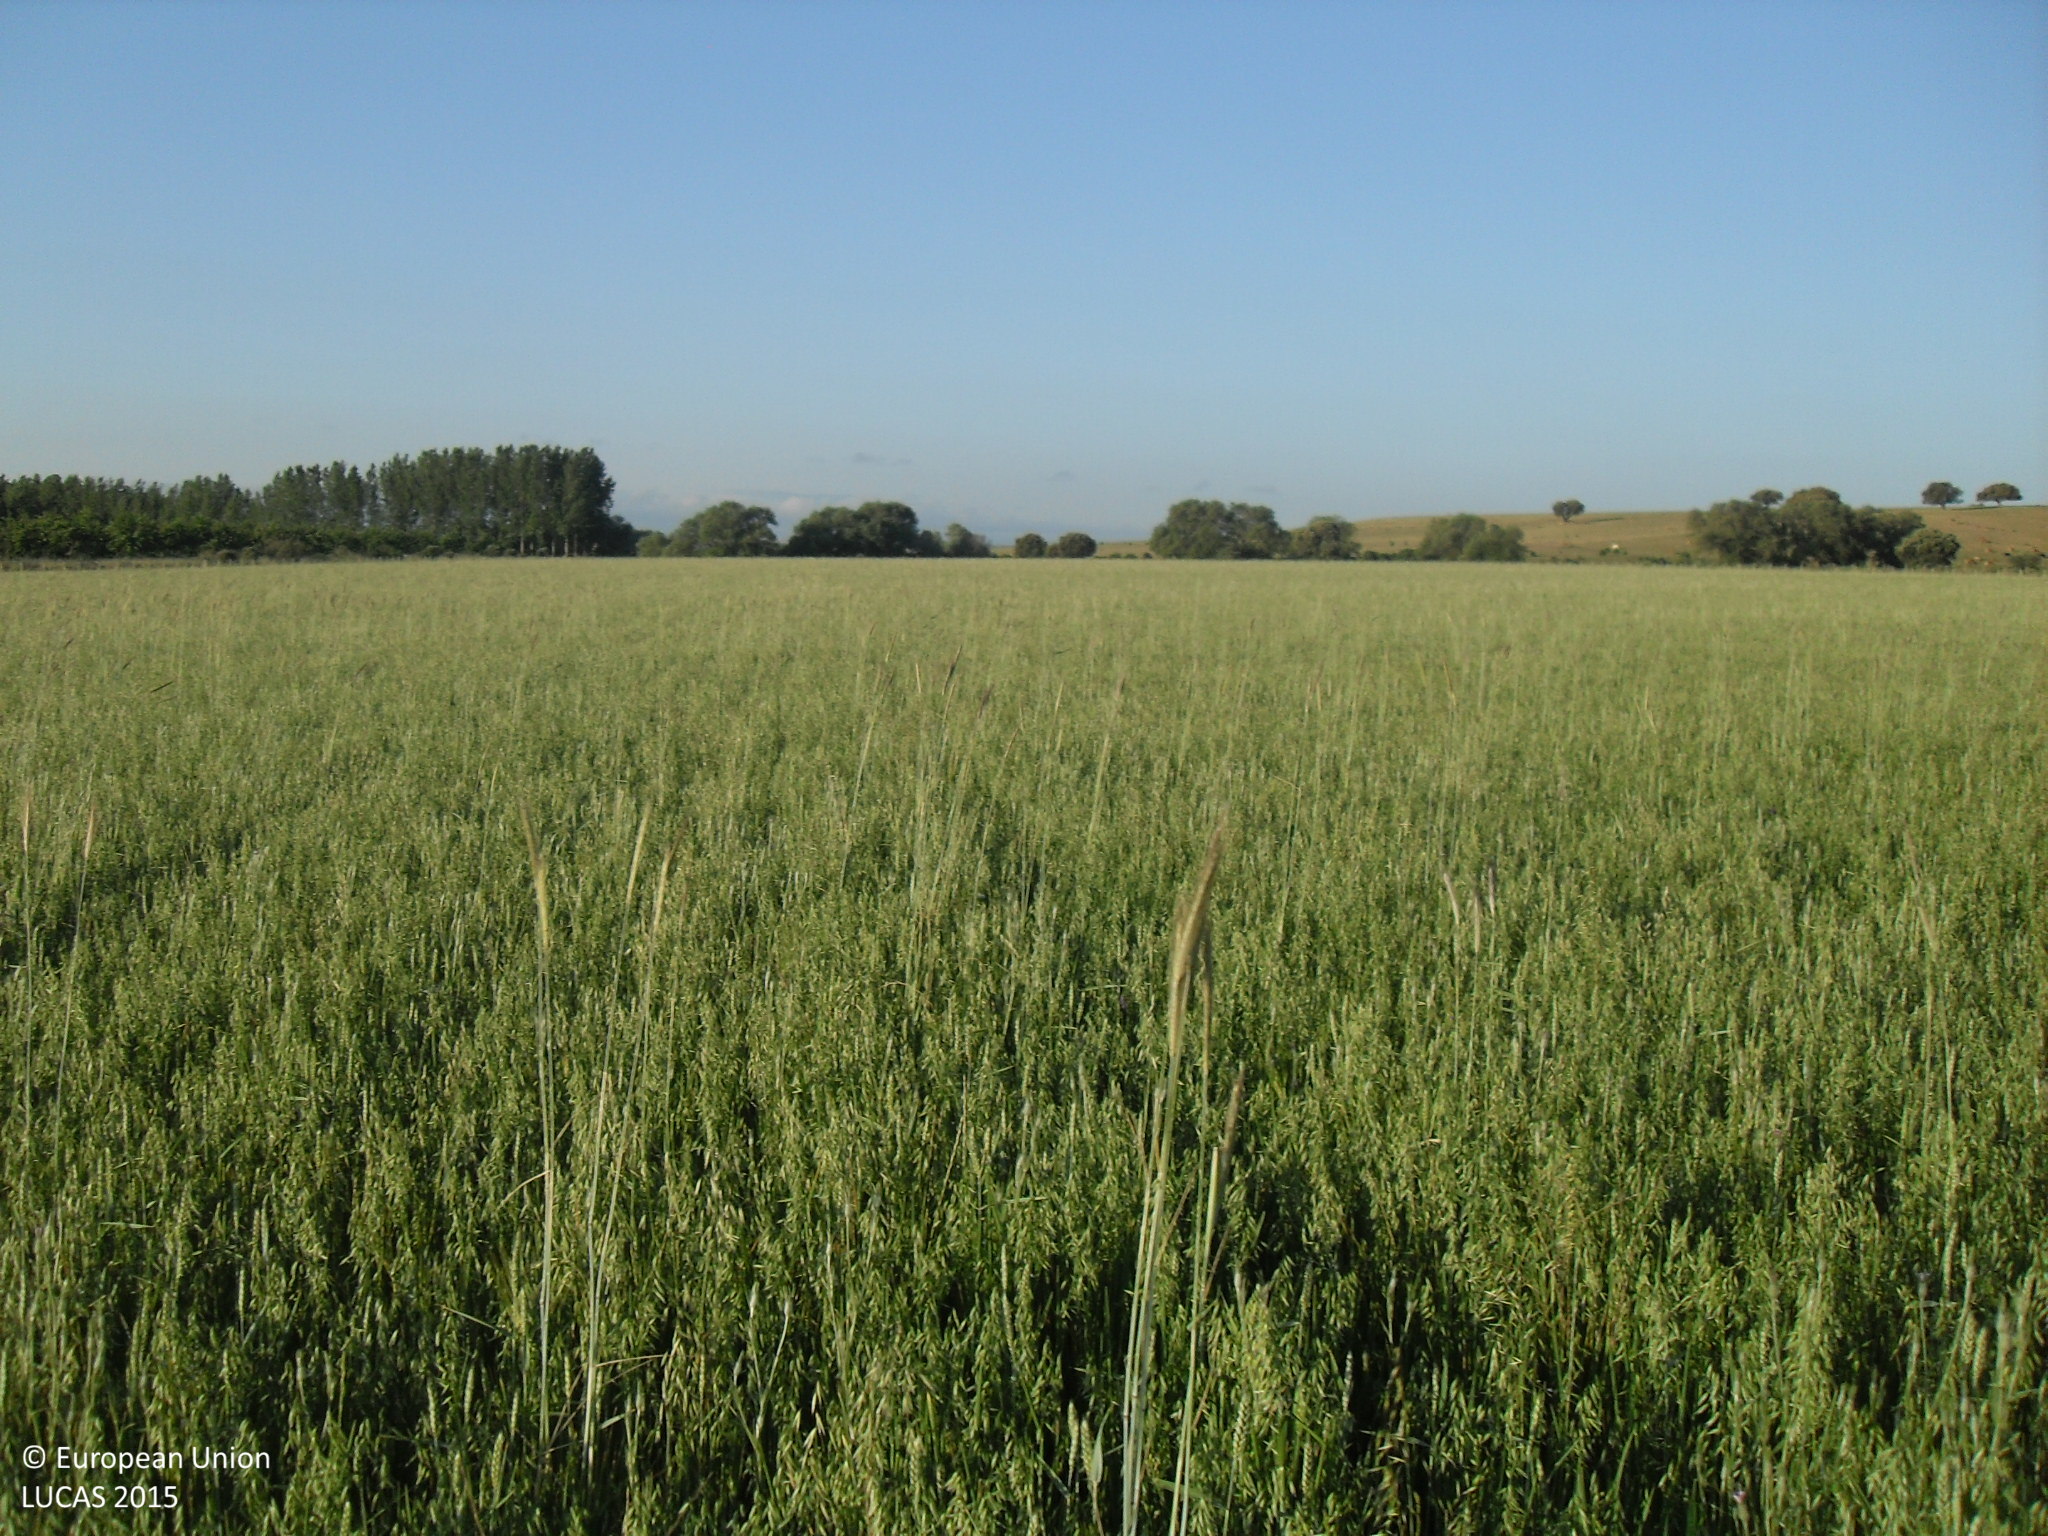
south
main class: Cropland
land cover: Oats
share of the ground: > 75 %
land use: Agriculture (excluding fallow land and kitchen gardens)
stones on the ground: < 10 %
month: May
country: ES
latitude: 40.7391
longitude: -5.5974
